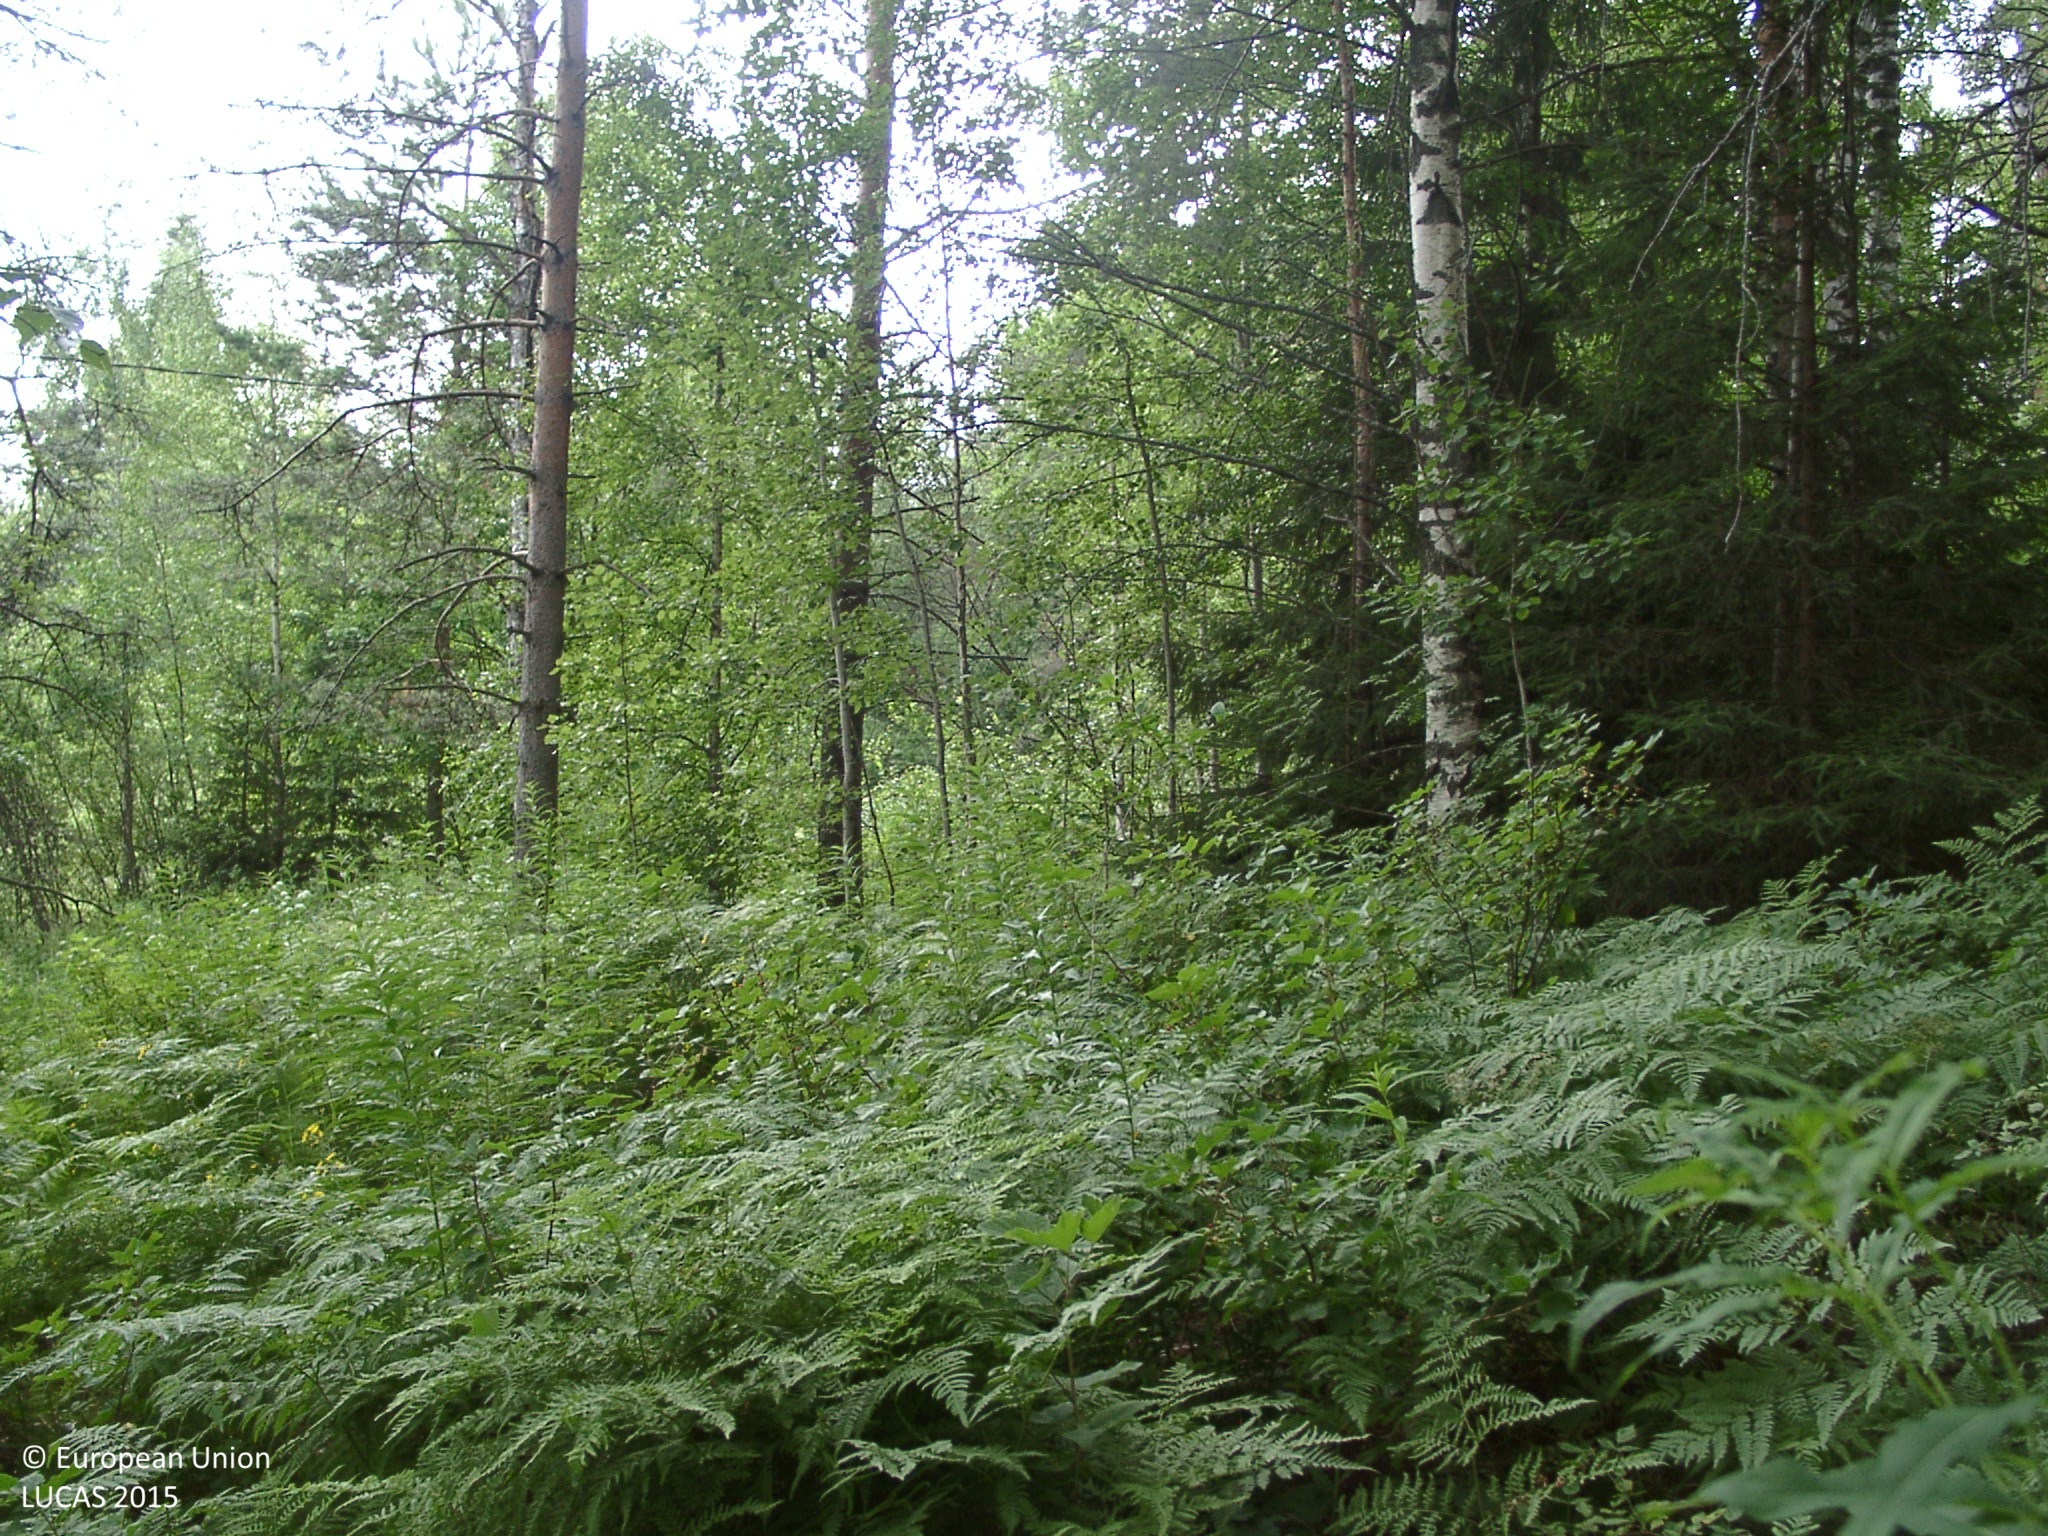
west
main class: Woodland
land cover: Pine dominated mixed woodland
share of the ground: 50 - 75 %
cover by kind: coniferous forest trees 35 %, broadleaved forest trees 30 %, herbaceous plants 30 %, shrubs 5 %
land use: Semi-natural and natural areas not in use
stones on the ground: < 10 %
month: July
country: FI
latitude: 61.7346
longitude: 24.7339
